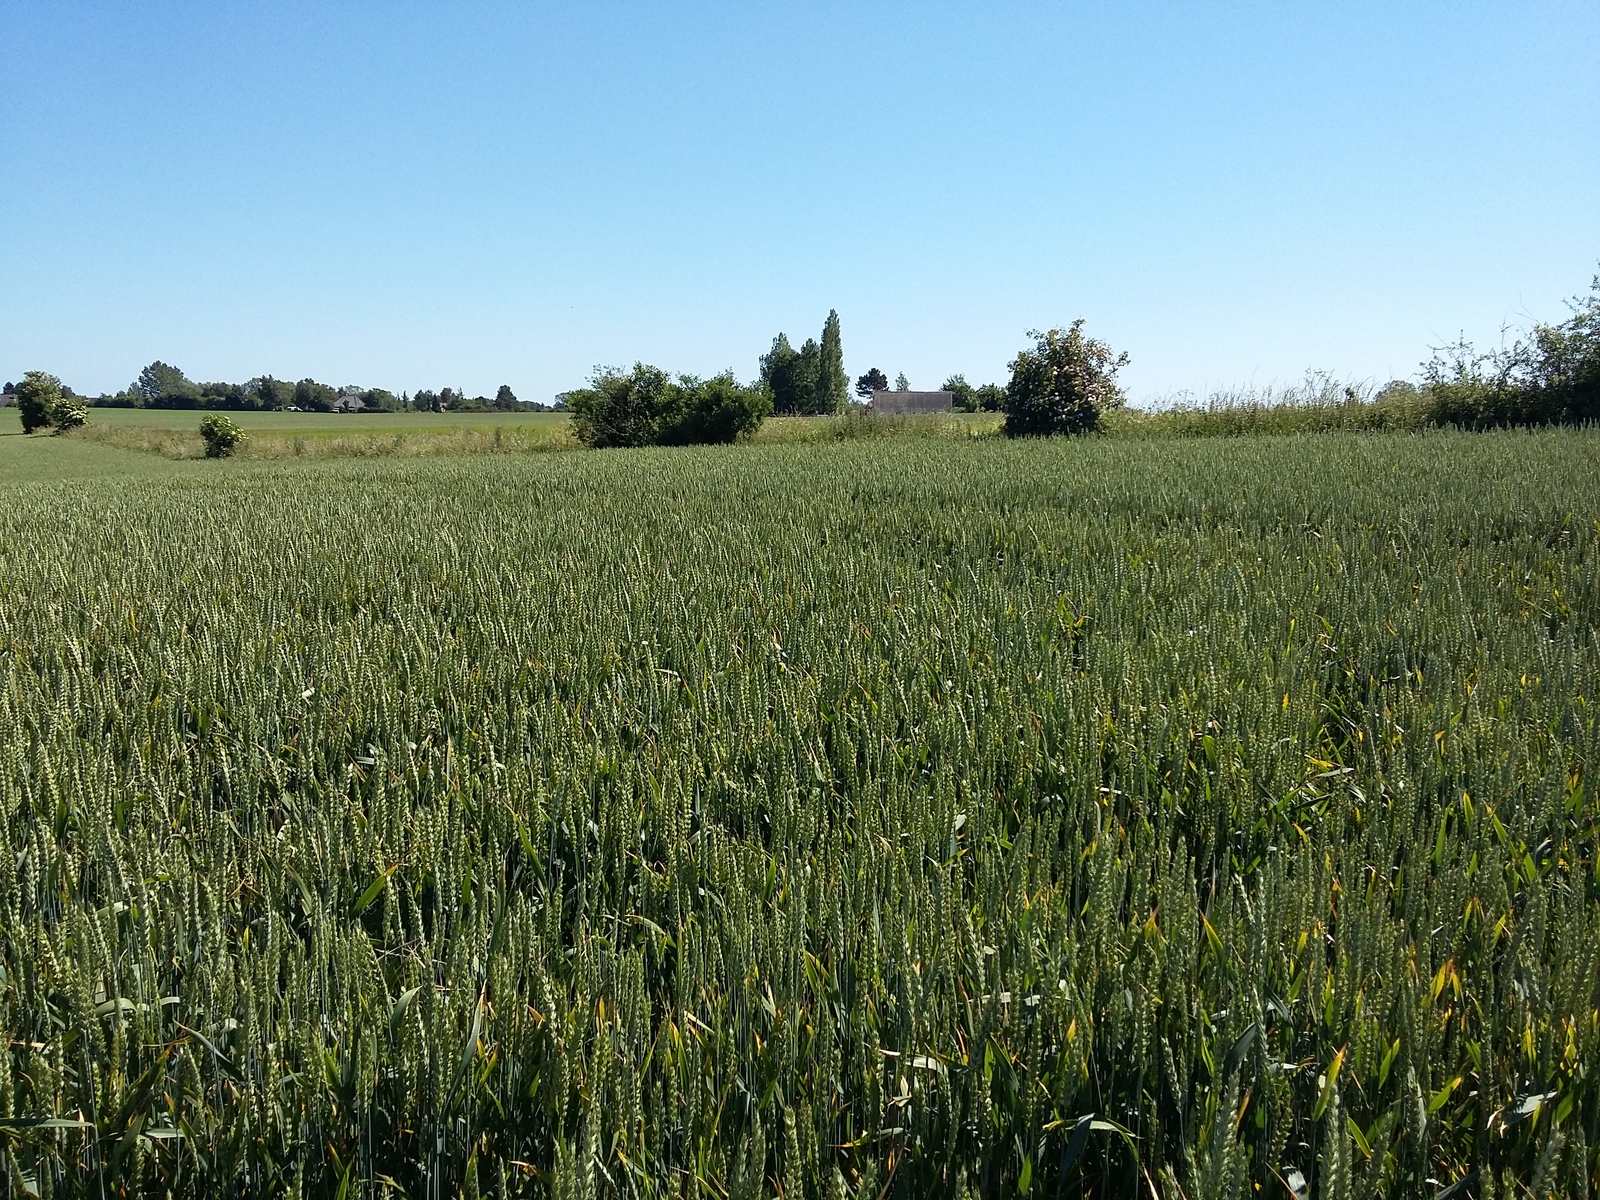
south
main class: Cropland
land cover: Common wheat
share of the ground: > 75 %
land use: Agriculture (excluding fallow land and kitchen gardens)
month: July
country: DK
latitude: 54.9288
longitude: 12.1678
